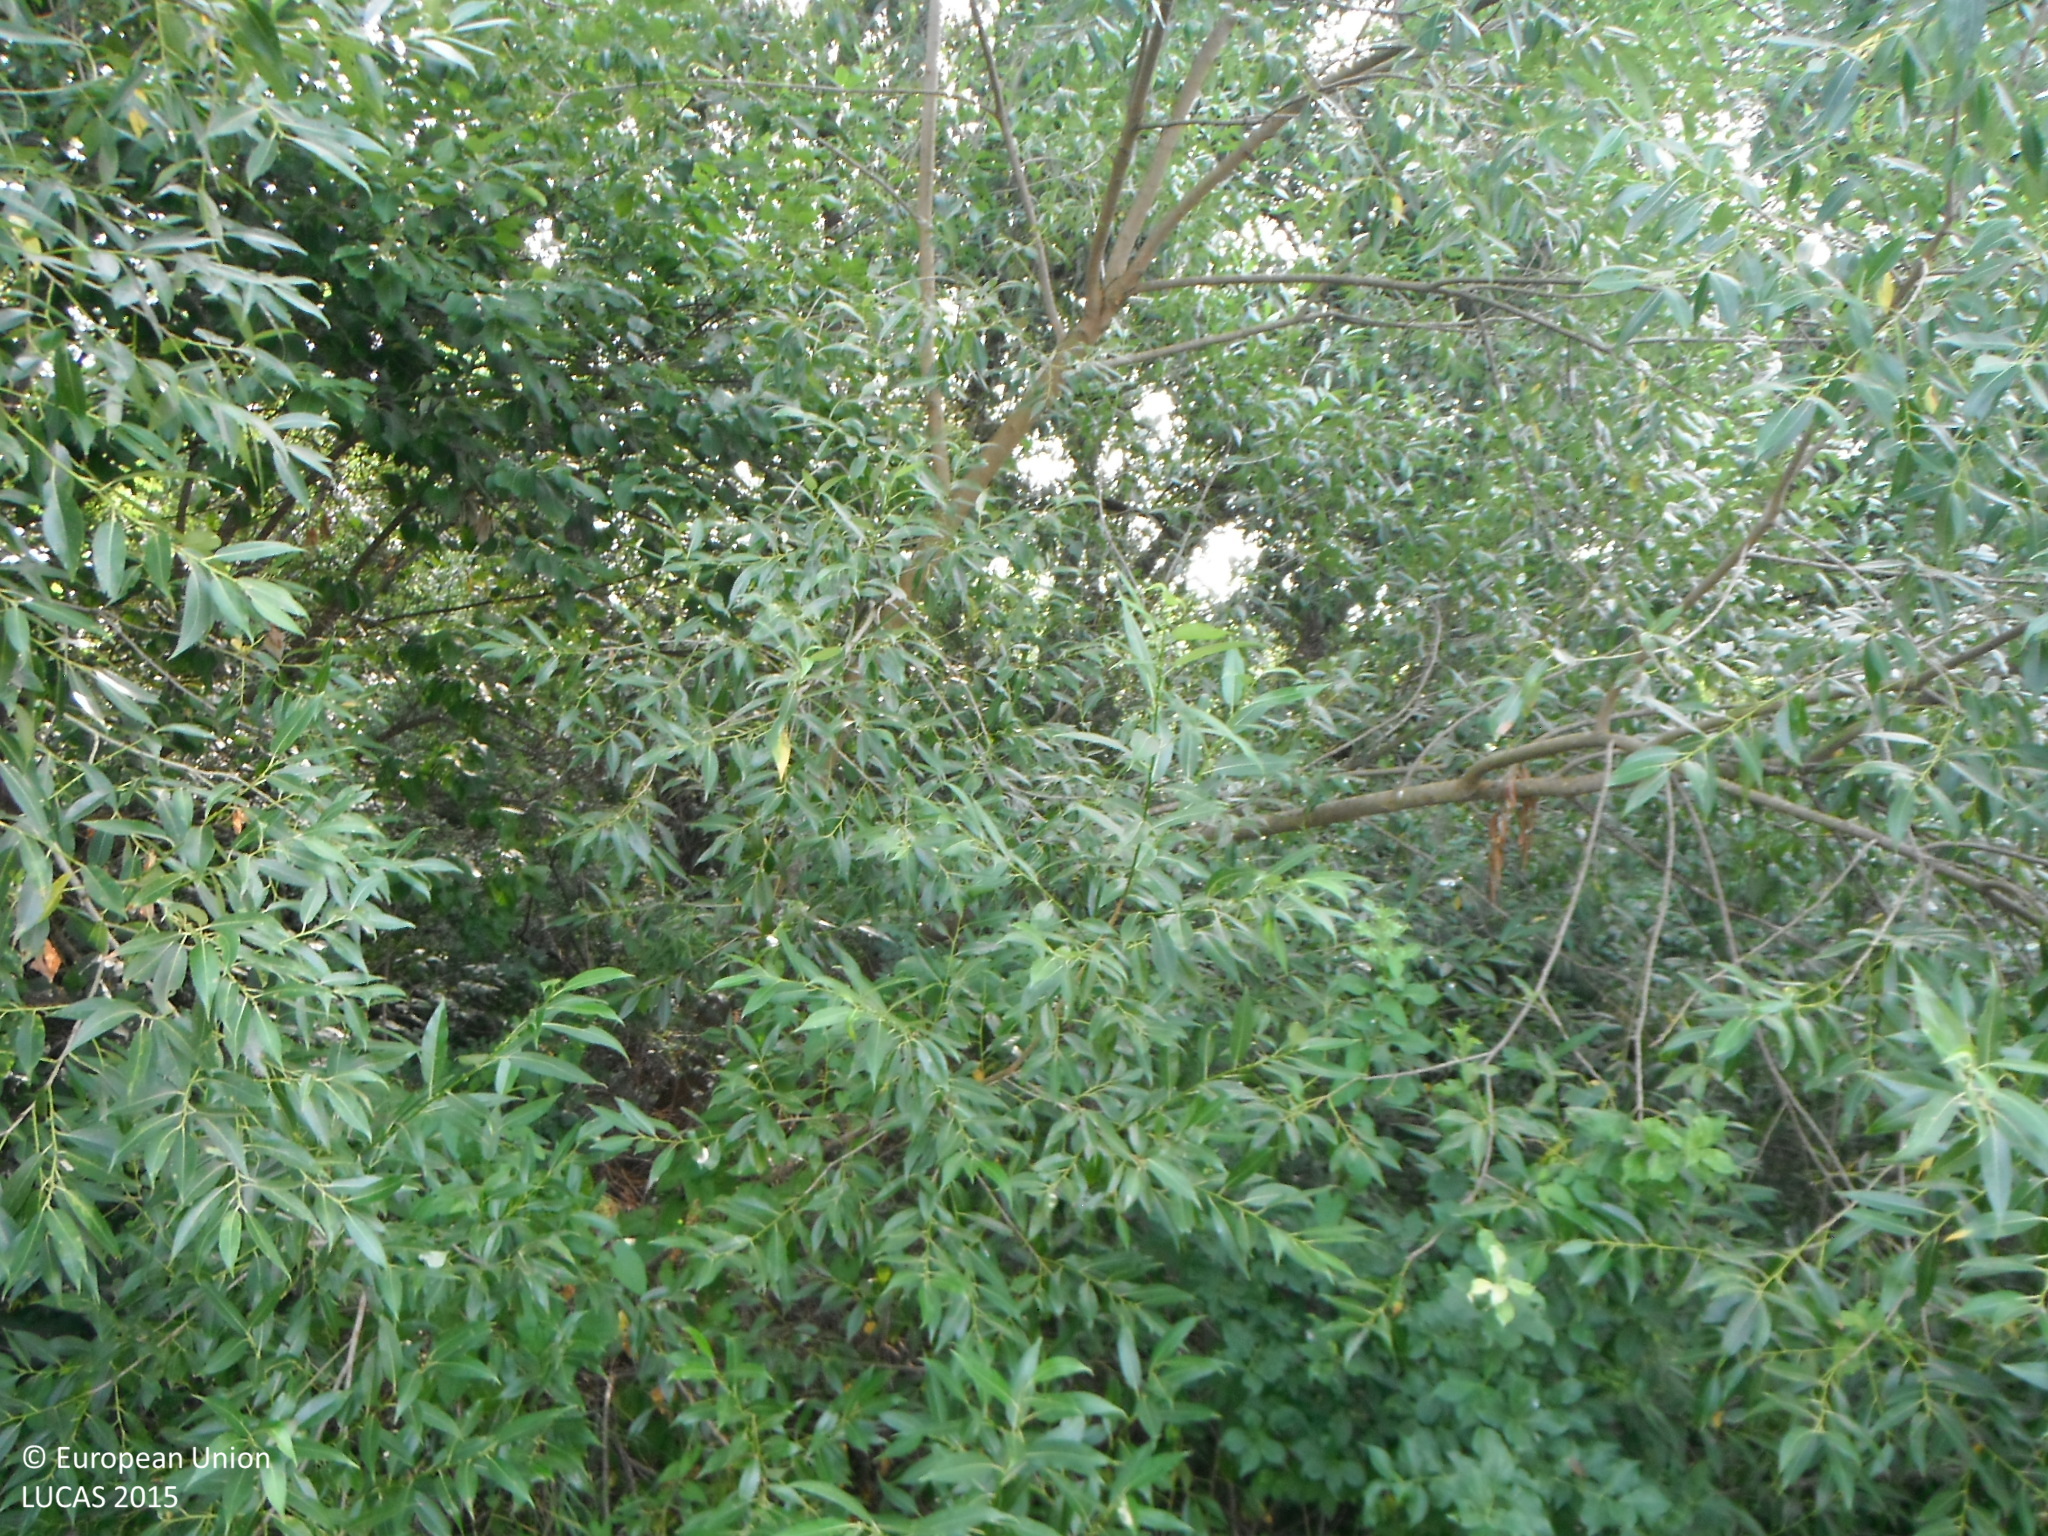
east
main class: Grassland
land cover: Grassland without tree/shrub cover
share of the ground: > 75 %
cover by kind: herbaceous plants 100 %
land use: Agriculture (excluding fallow land and kitchen gardens)
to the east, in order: Grassland without tree/shrub cover; Broadleaved woodland; Rivers and streams; Broadleaved woodland; Grassland without tree/shrub cover; Tracks; Grassland without tree/shrub cover; Shrubland without tree cover; Grassland without tree/shrub cover
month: July
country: SK
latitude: 48.5851
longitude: 19.1455
